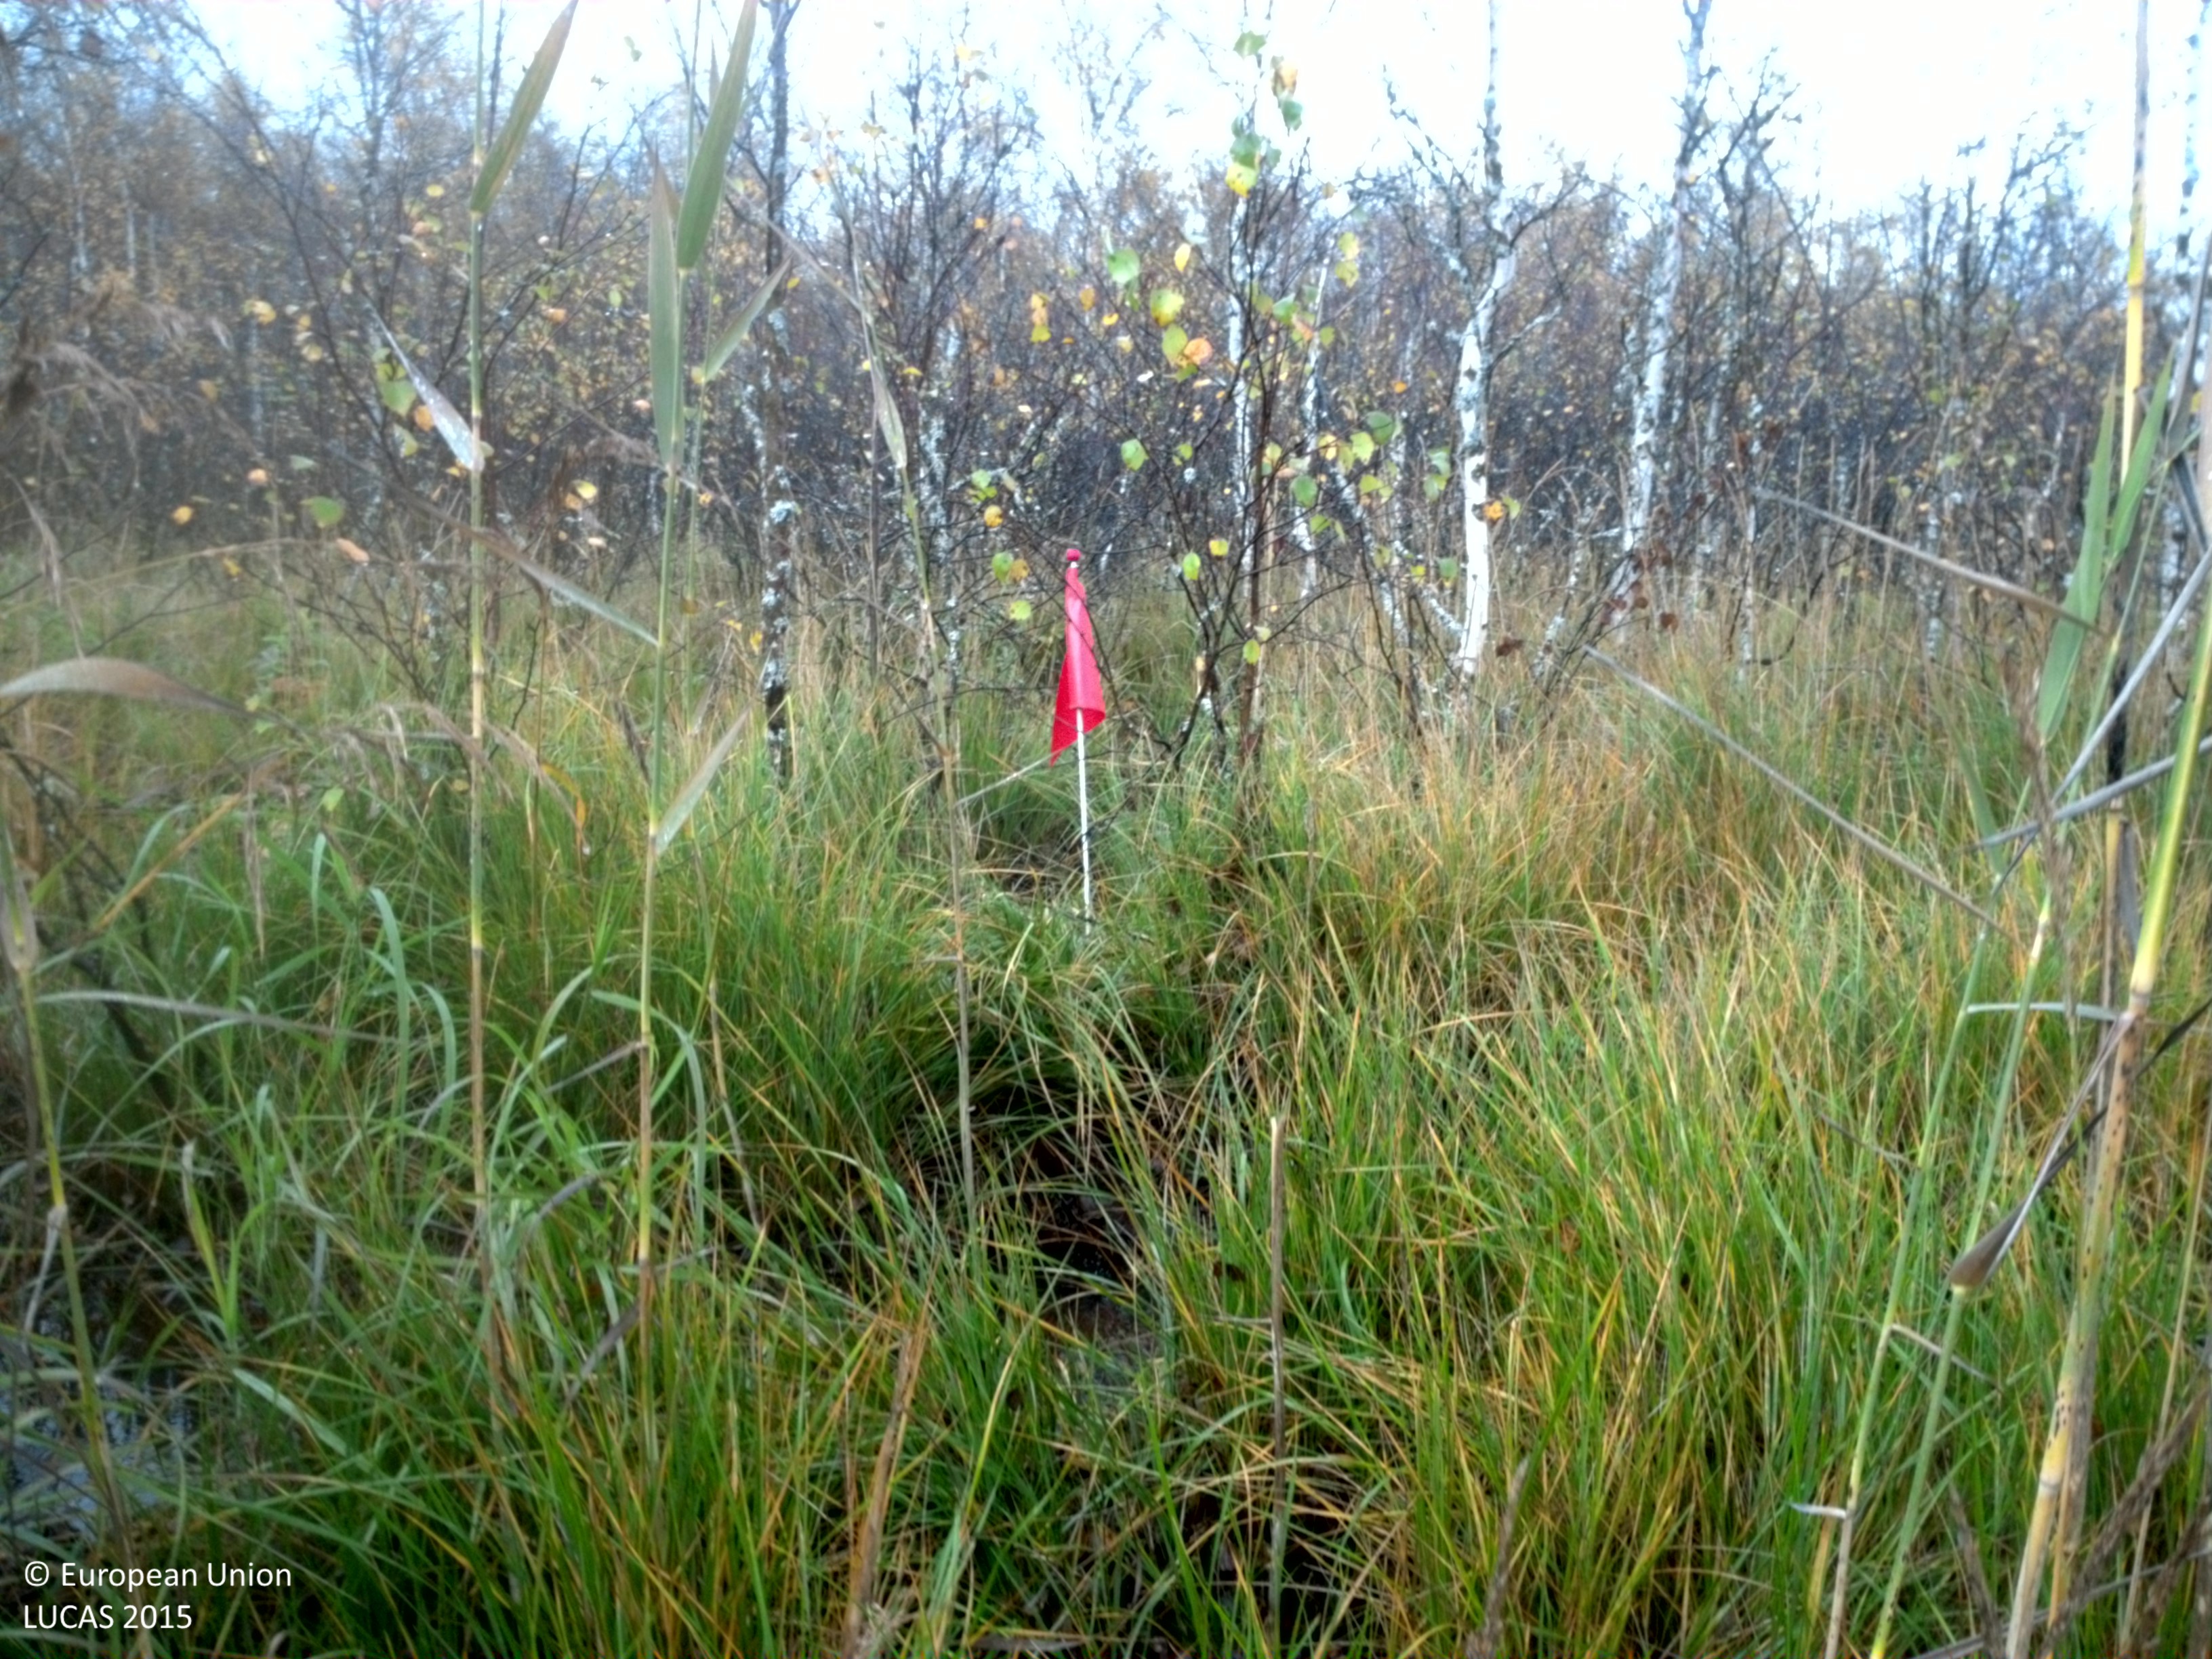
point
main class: Woodland
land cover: Broadleaved woodland
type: mire and swamp forests
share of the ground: 50 - 75 %
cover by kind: broadleaved forest trees 55 %, herbaceous plants 35 %
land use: Semi-natural and natural areas not in use
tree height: > 5 m
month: September
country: SE
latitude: 65.6393
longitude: 22.0801
